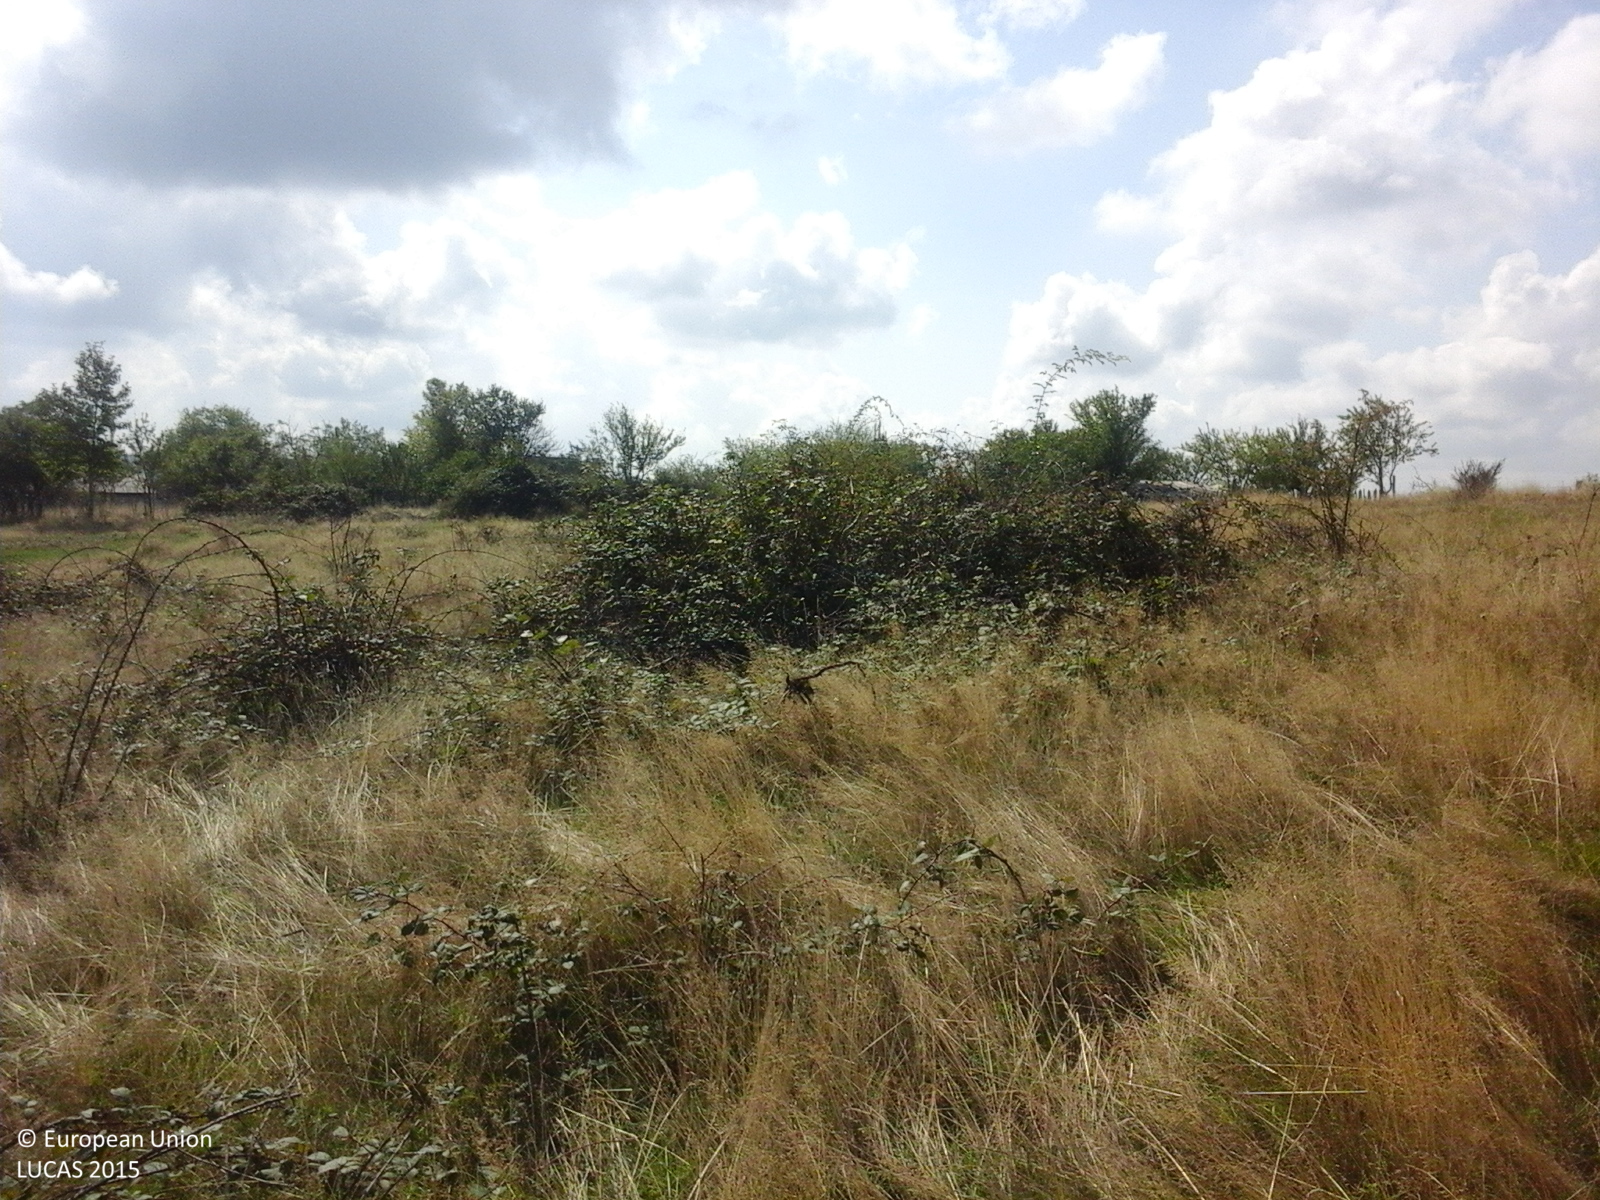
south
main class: Grassland
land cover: Grassland with sparse tree/shrub cover
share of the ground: > 75 %
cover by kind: herbaceous plants 95 %, broadleaved forest trees 5 %
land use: Agriculture (excluding fallow land and kitchen gardens)
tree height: > 5 m
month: September
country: RO
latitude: 45.1502
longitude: 23.4509
